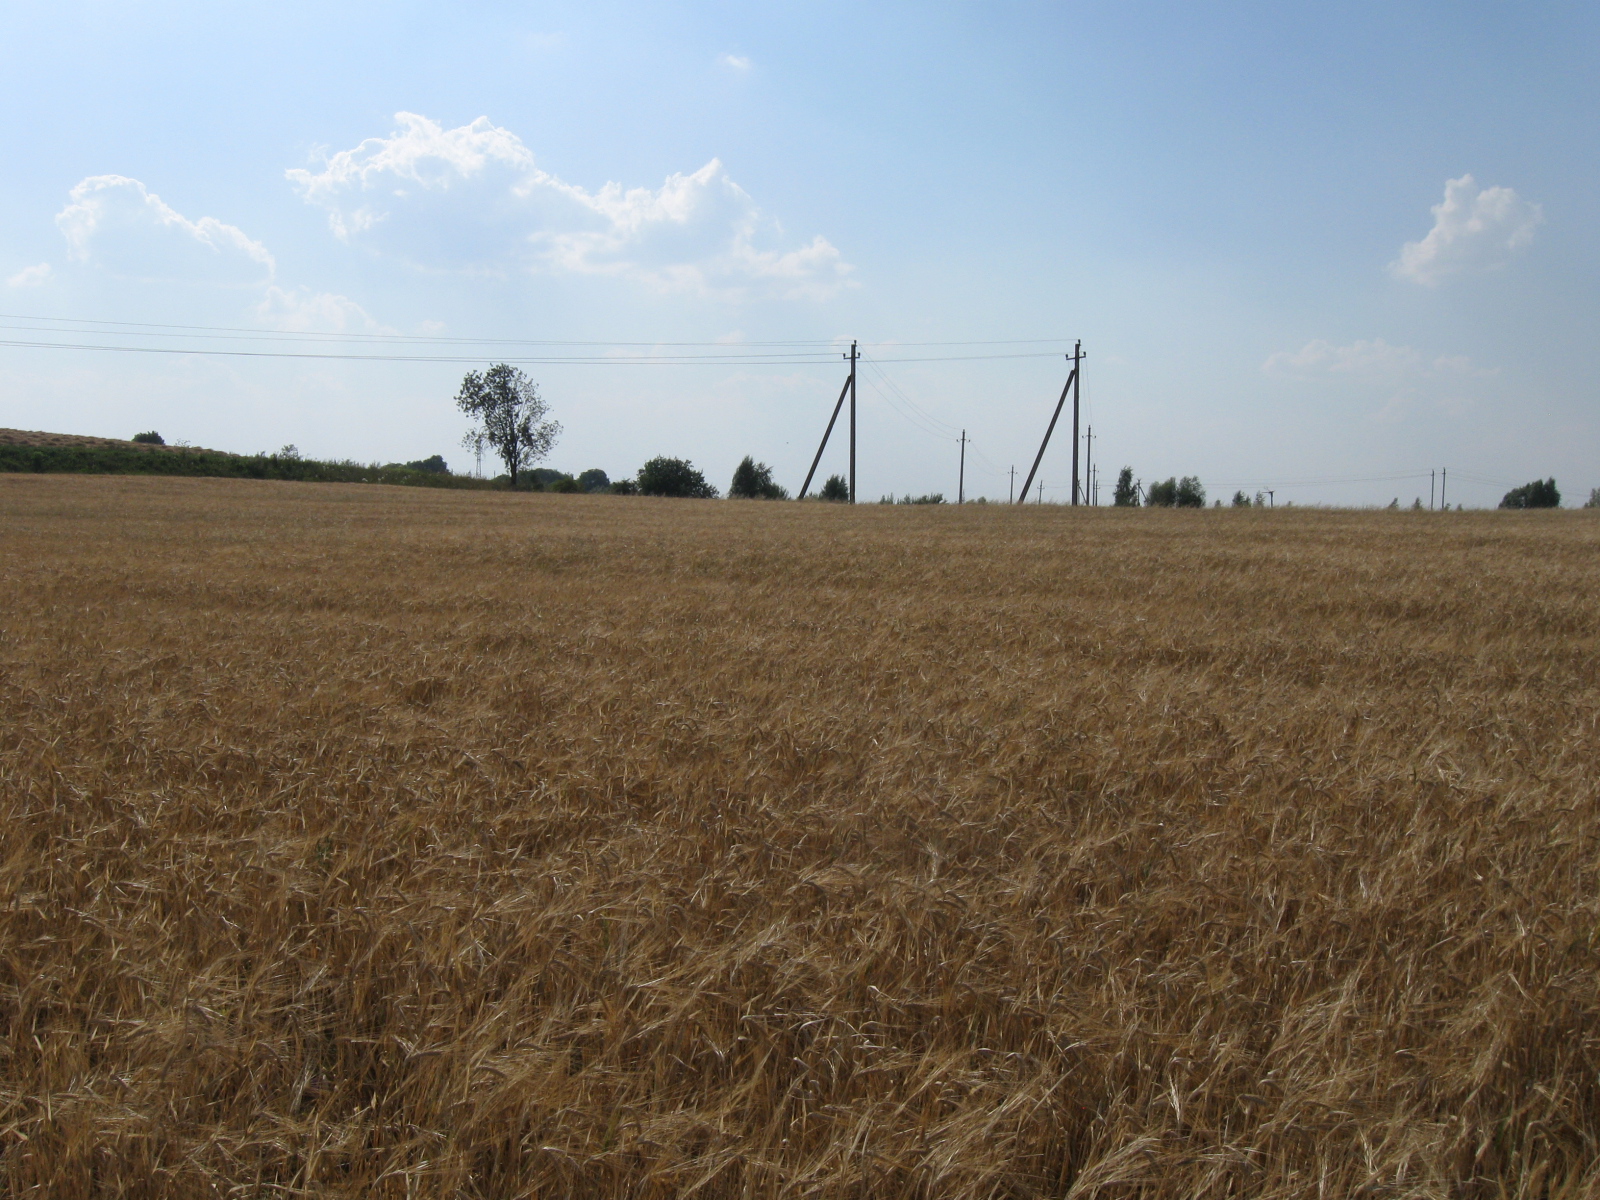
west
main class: Cropland
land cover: Barley
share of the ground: > 75 %
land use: Agriculture (excluding fallow land and kitchen gardens)
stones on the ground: < 10 %
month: August
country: LT
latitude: 54.4198
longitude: 23.2539
